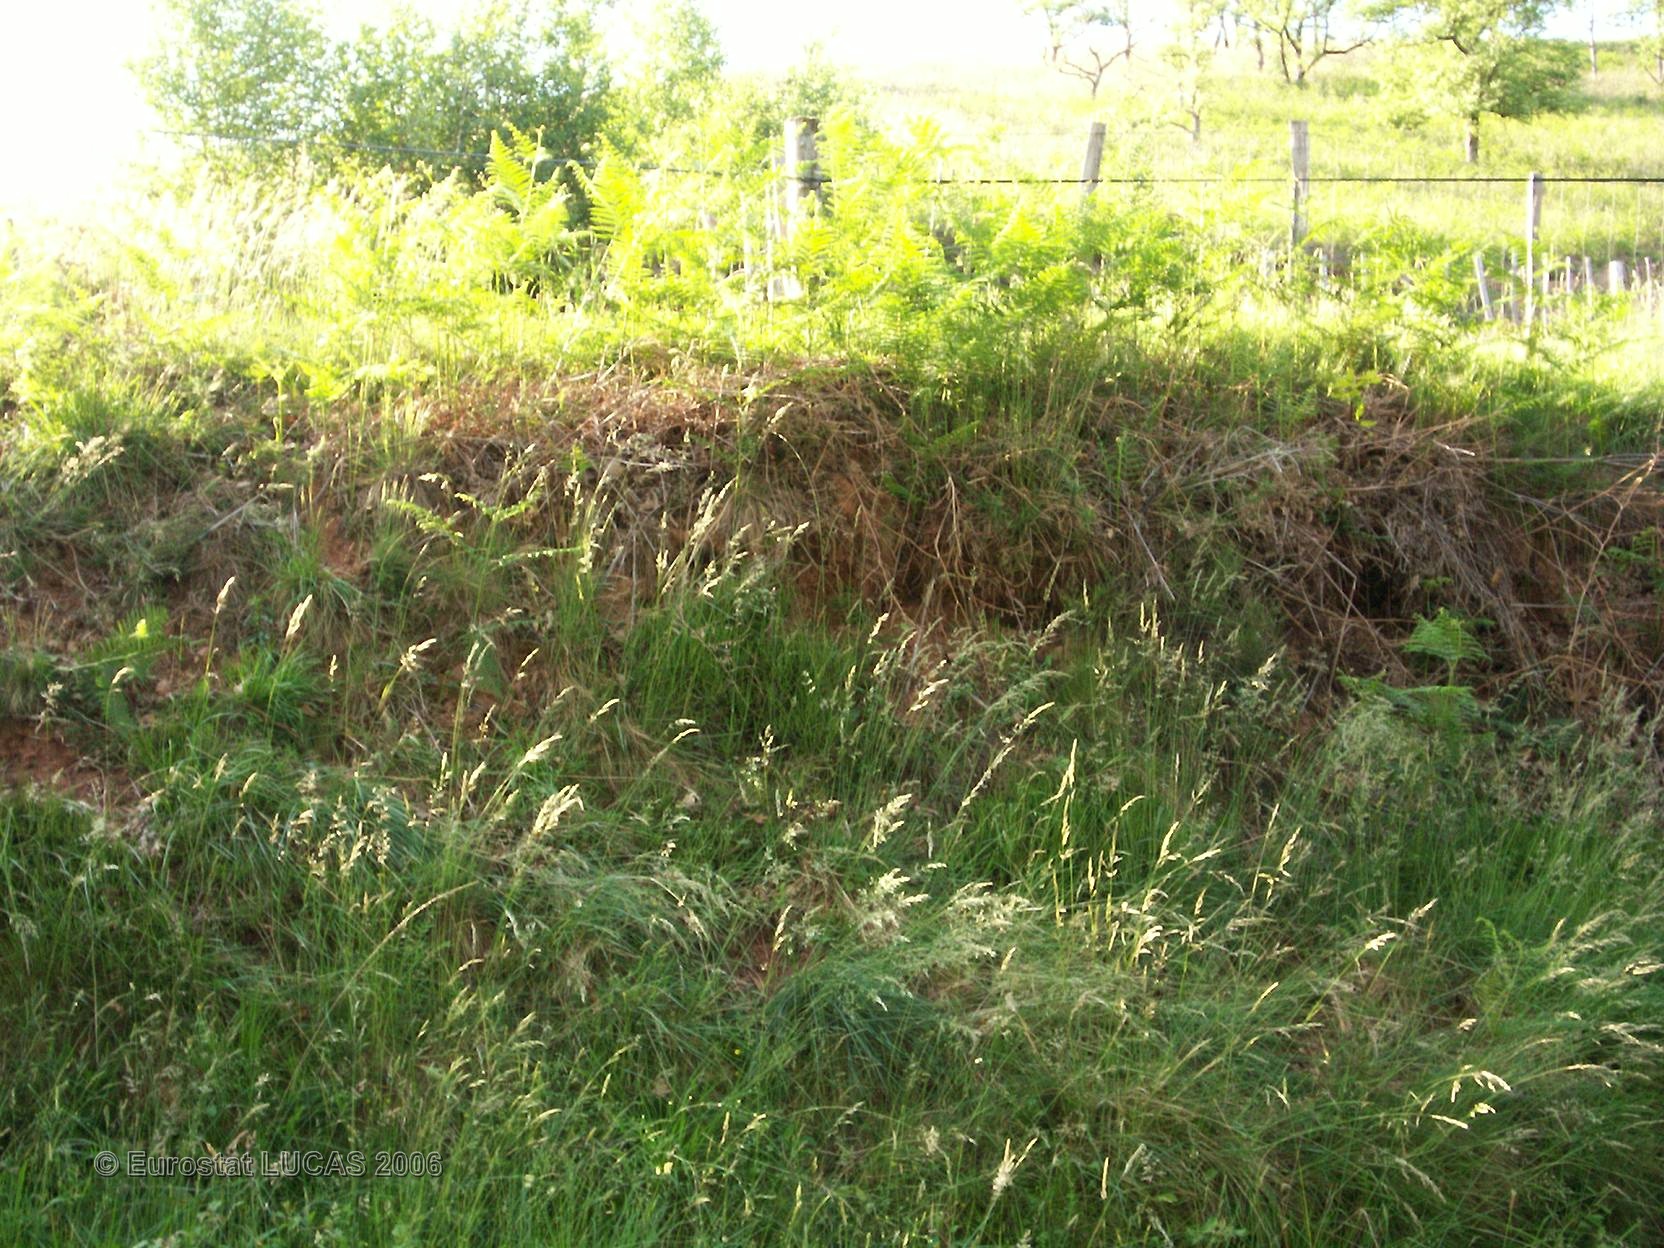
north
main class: Woodland
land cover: Broadleaved forest
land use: Forestry
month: May
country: FR
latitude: 43.2541
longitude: -1.3349
